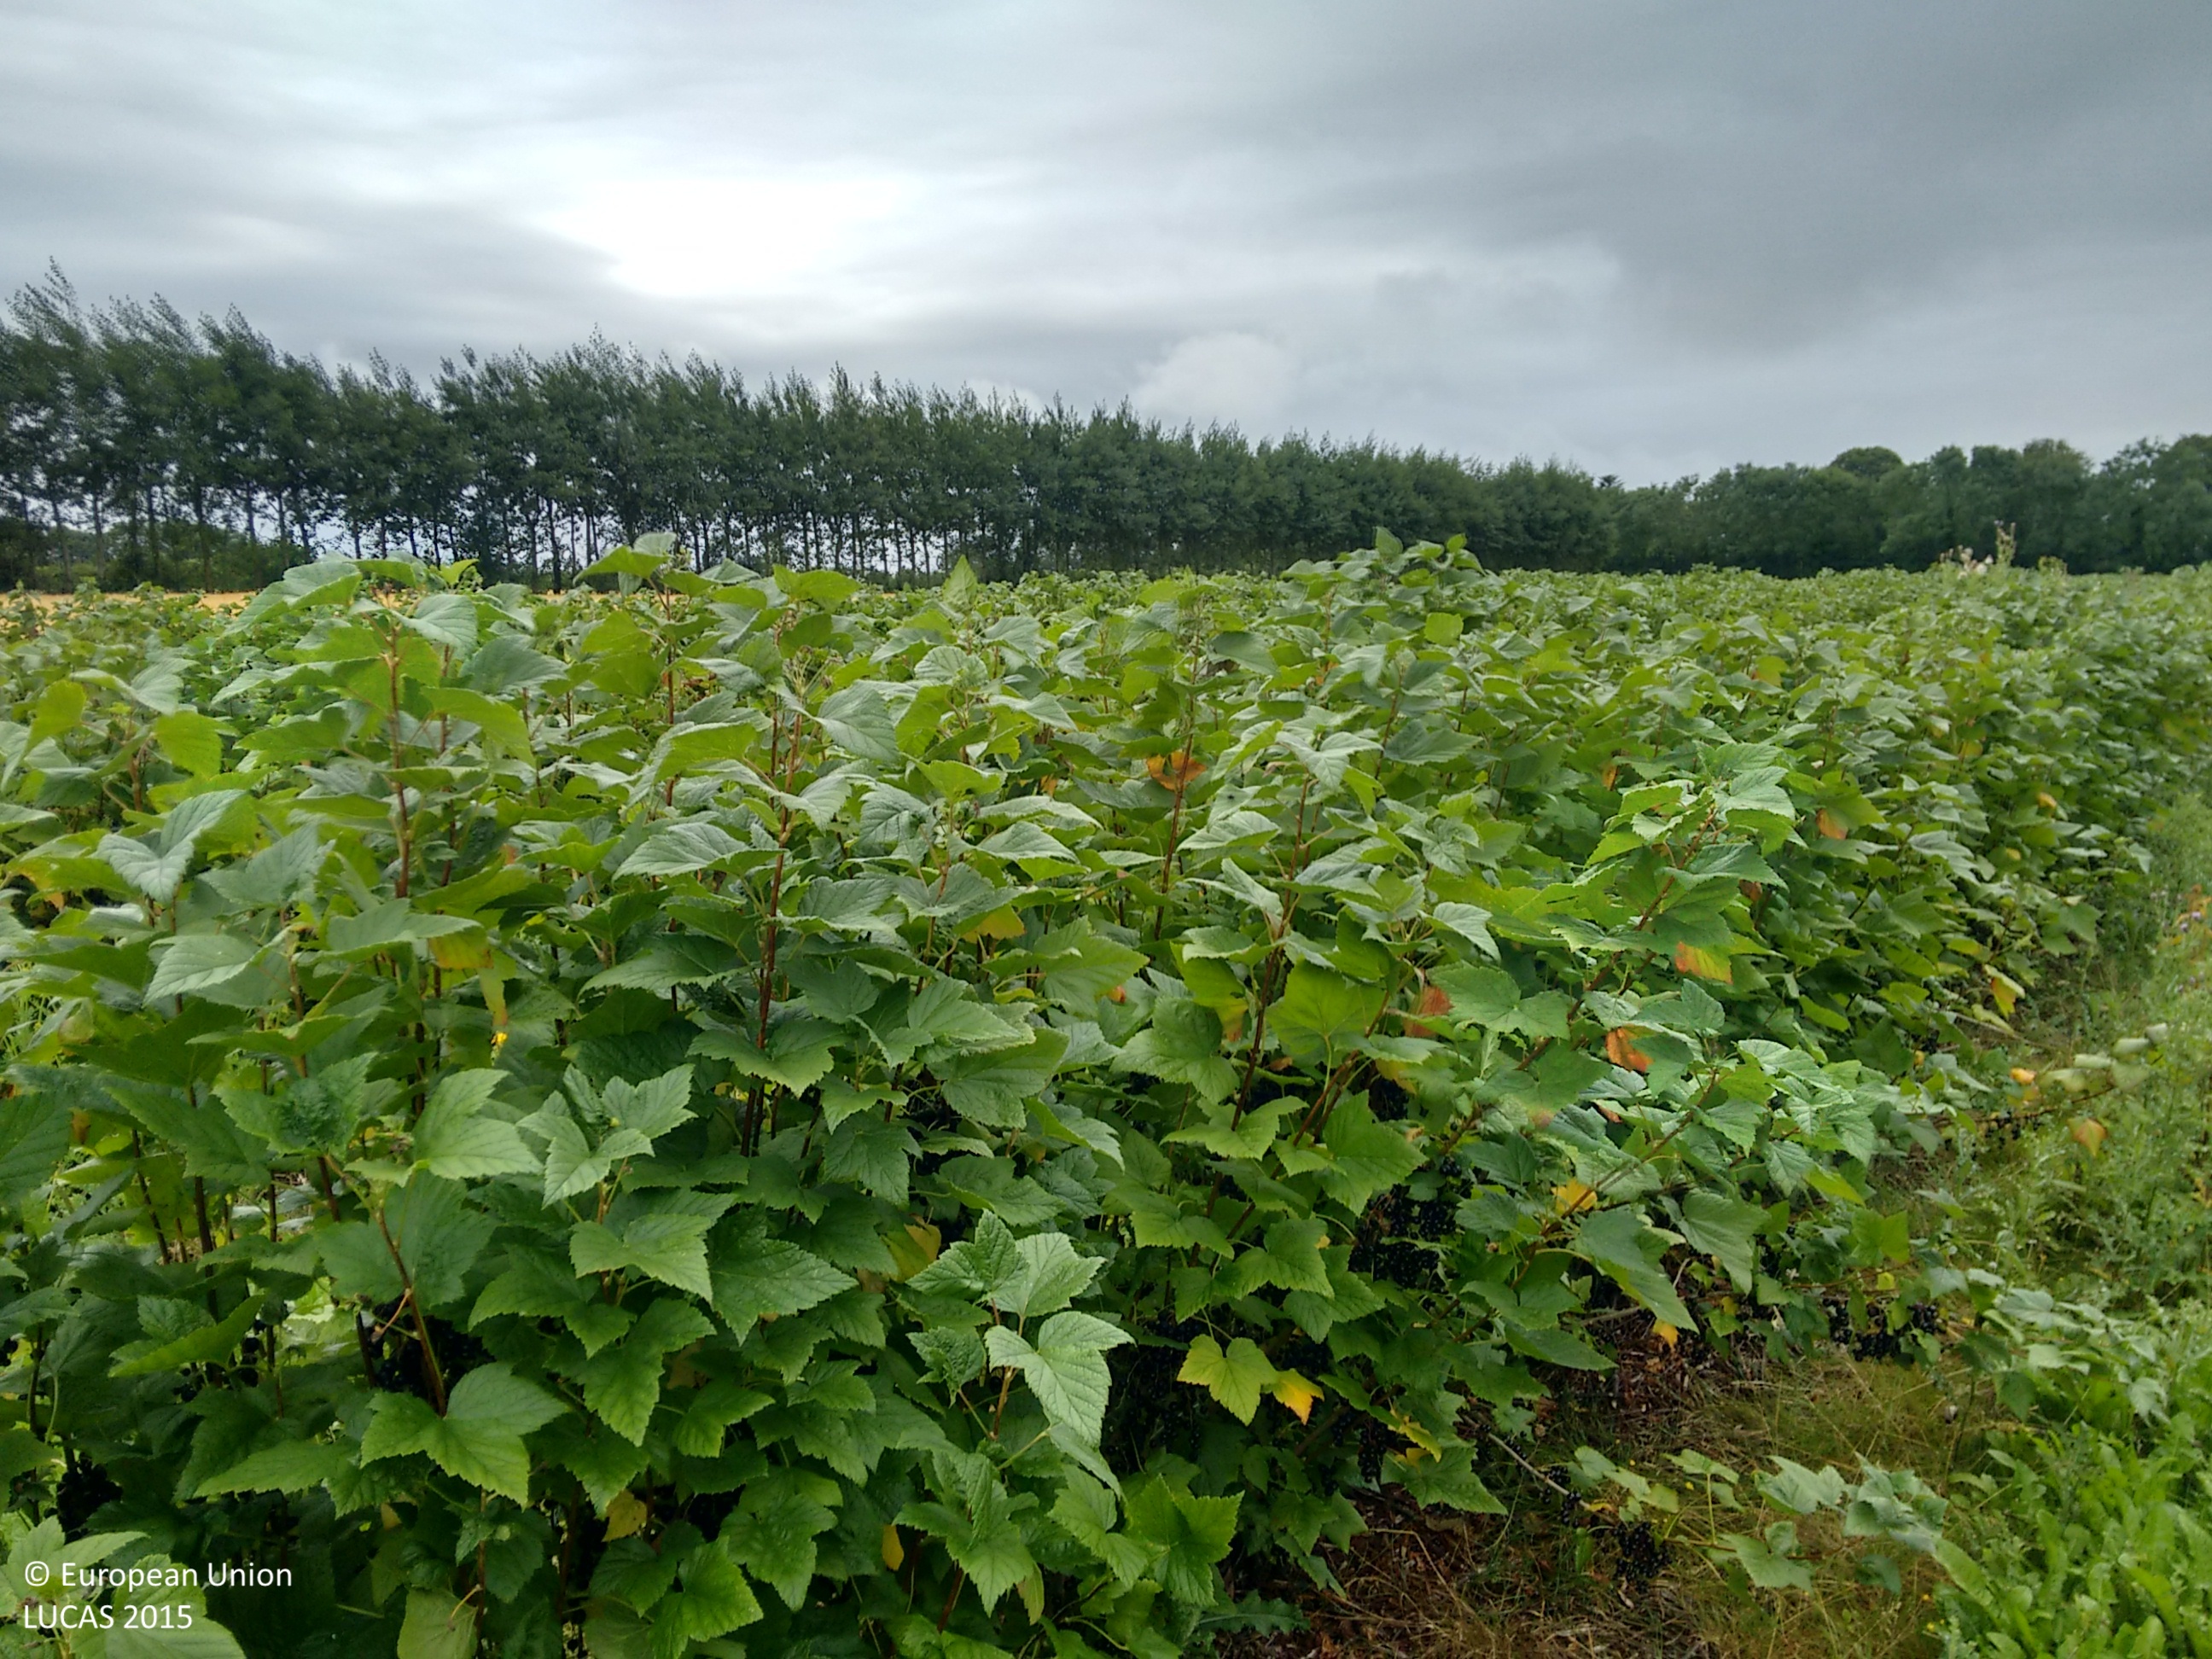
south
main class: Cropland
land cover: Other fruit trees and berries
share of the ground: 50 - 75 %
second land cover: Grassland without tree/shrub cover
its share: 50 - 75 %
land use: Agriculture (excluding fallow land and kitchen gardens)
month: August
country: IE
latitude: 52.4995
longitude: -6.6147
